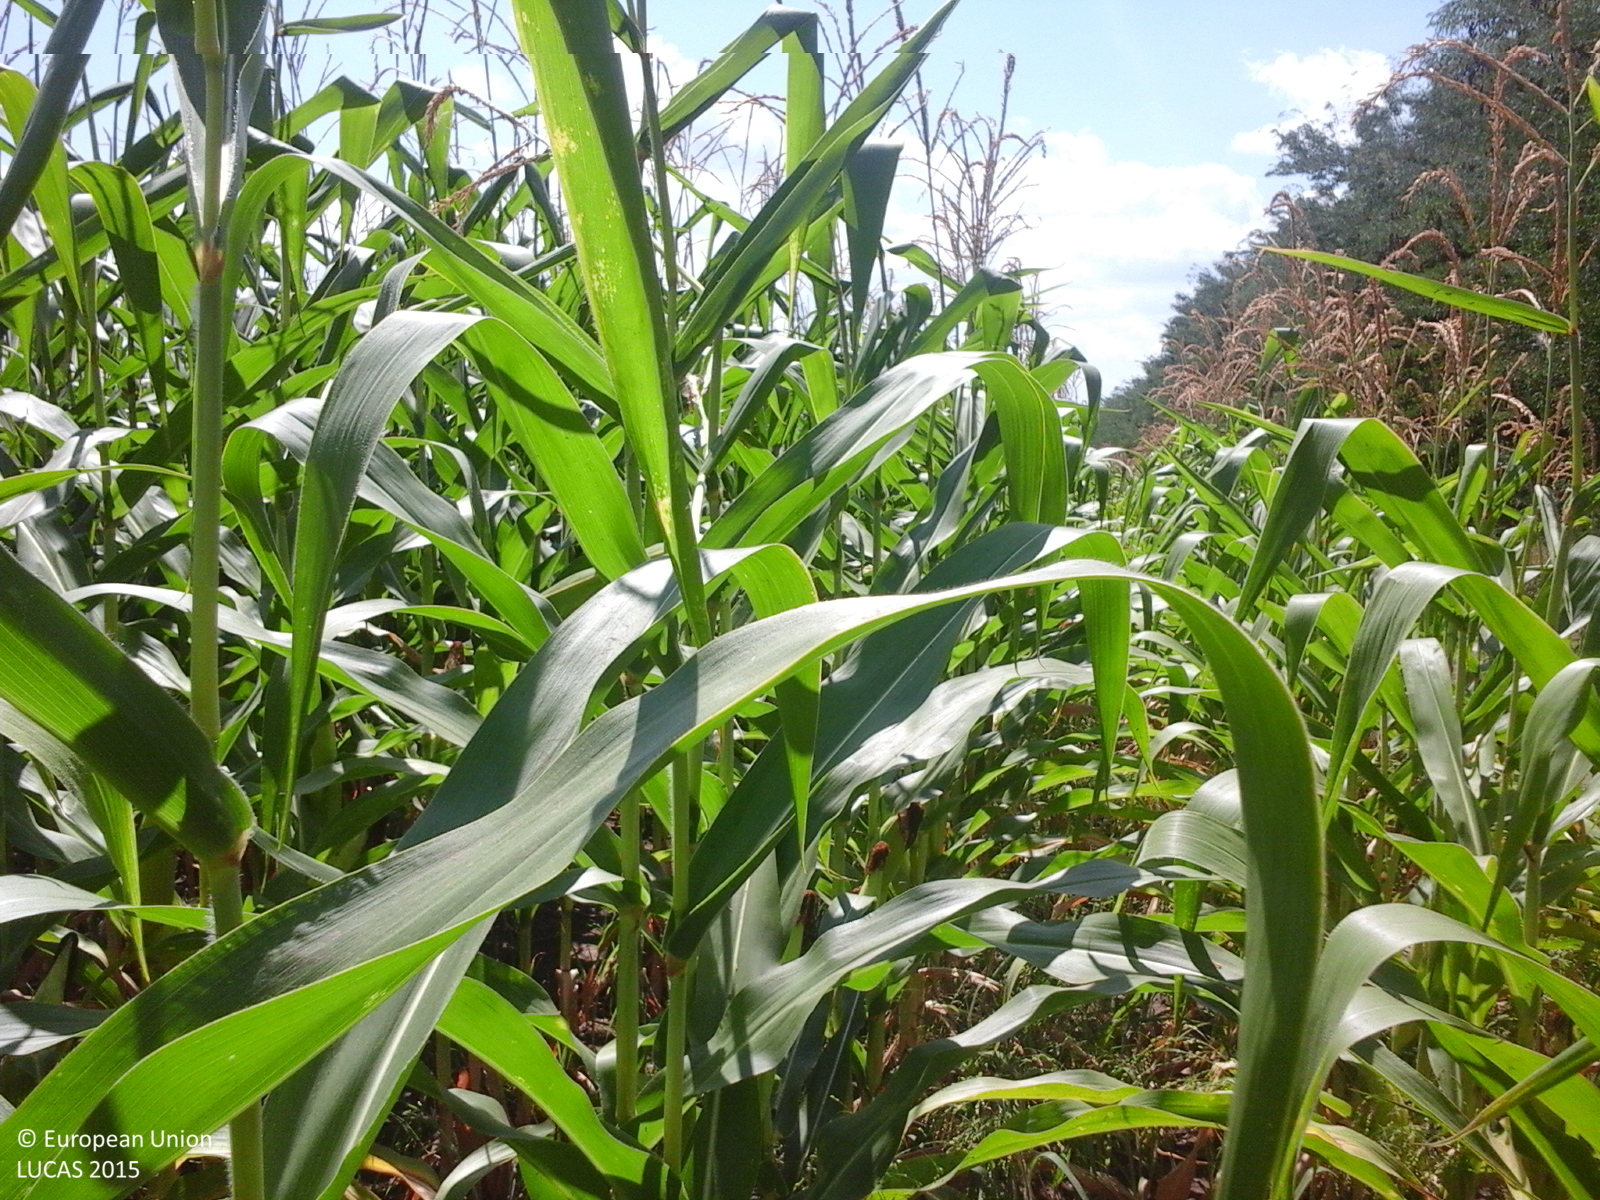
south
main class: Cropland
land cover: Maize
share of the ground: > 75 %
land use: Agriculture (excluding fallow land and kitchen gardens)
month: July
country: RO
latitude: 46.5529
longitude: 27.8203
